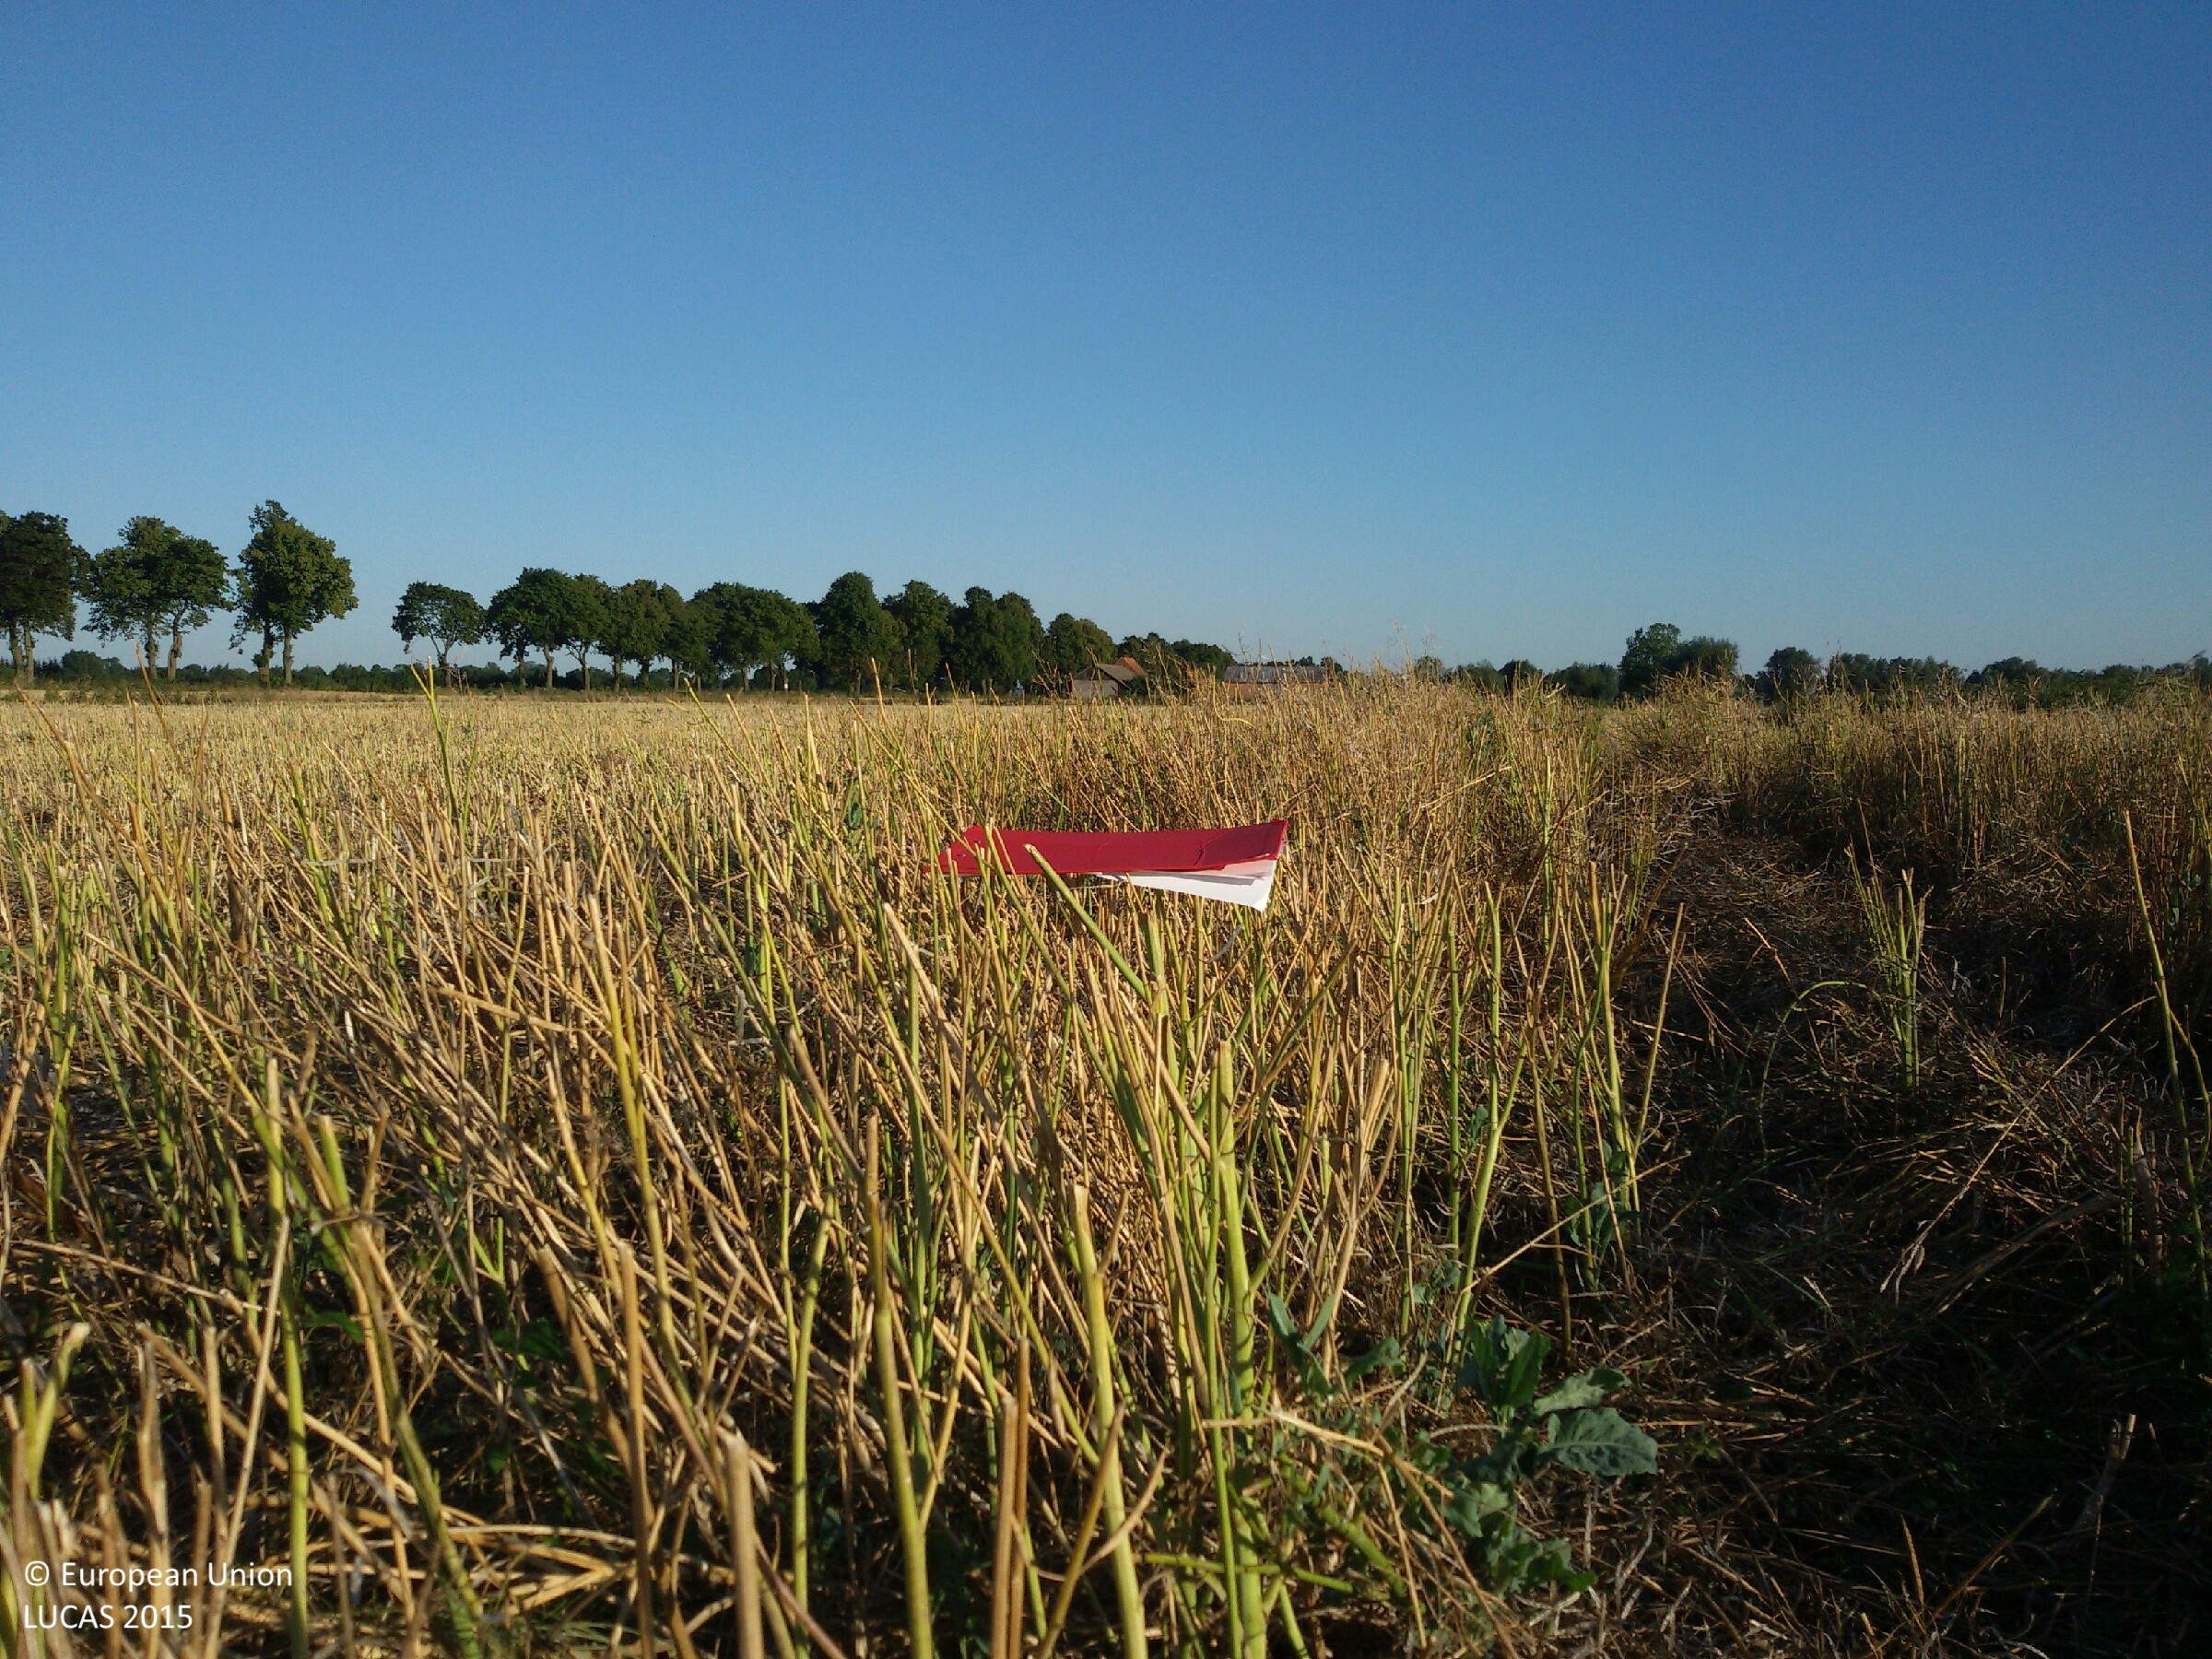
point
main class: Cropland
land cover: Rape and turnip rape
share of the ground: 50 - 75 %
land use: Agriculture (excluding fallow land and kitchen gardens)
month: August
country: PL
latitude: 54.0527
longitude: 19.3576
